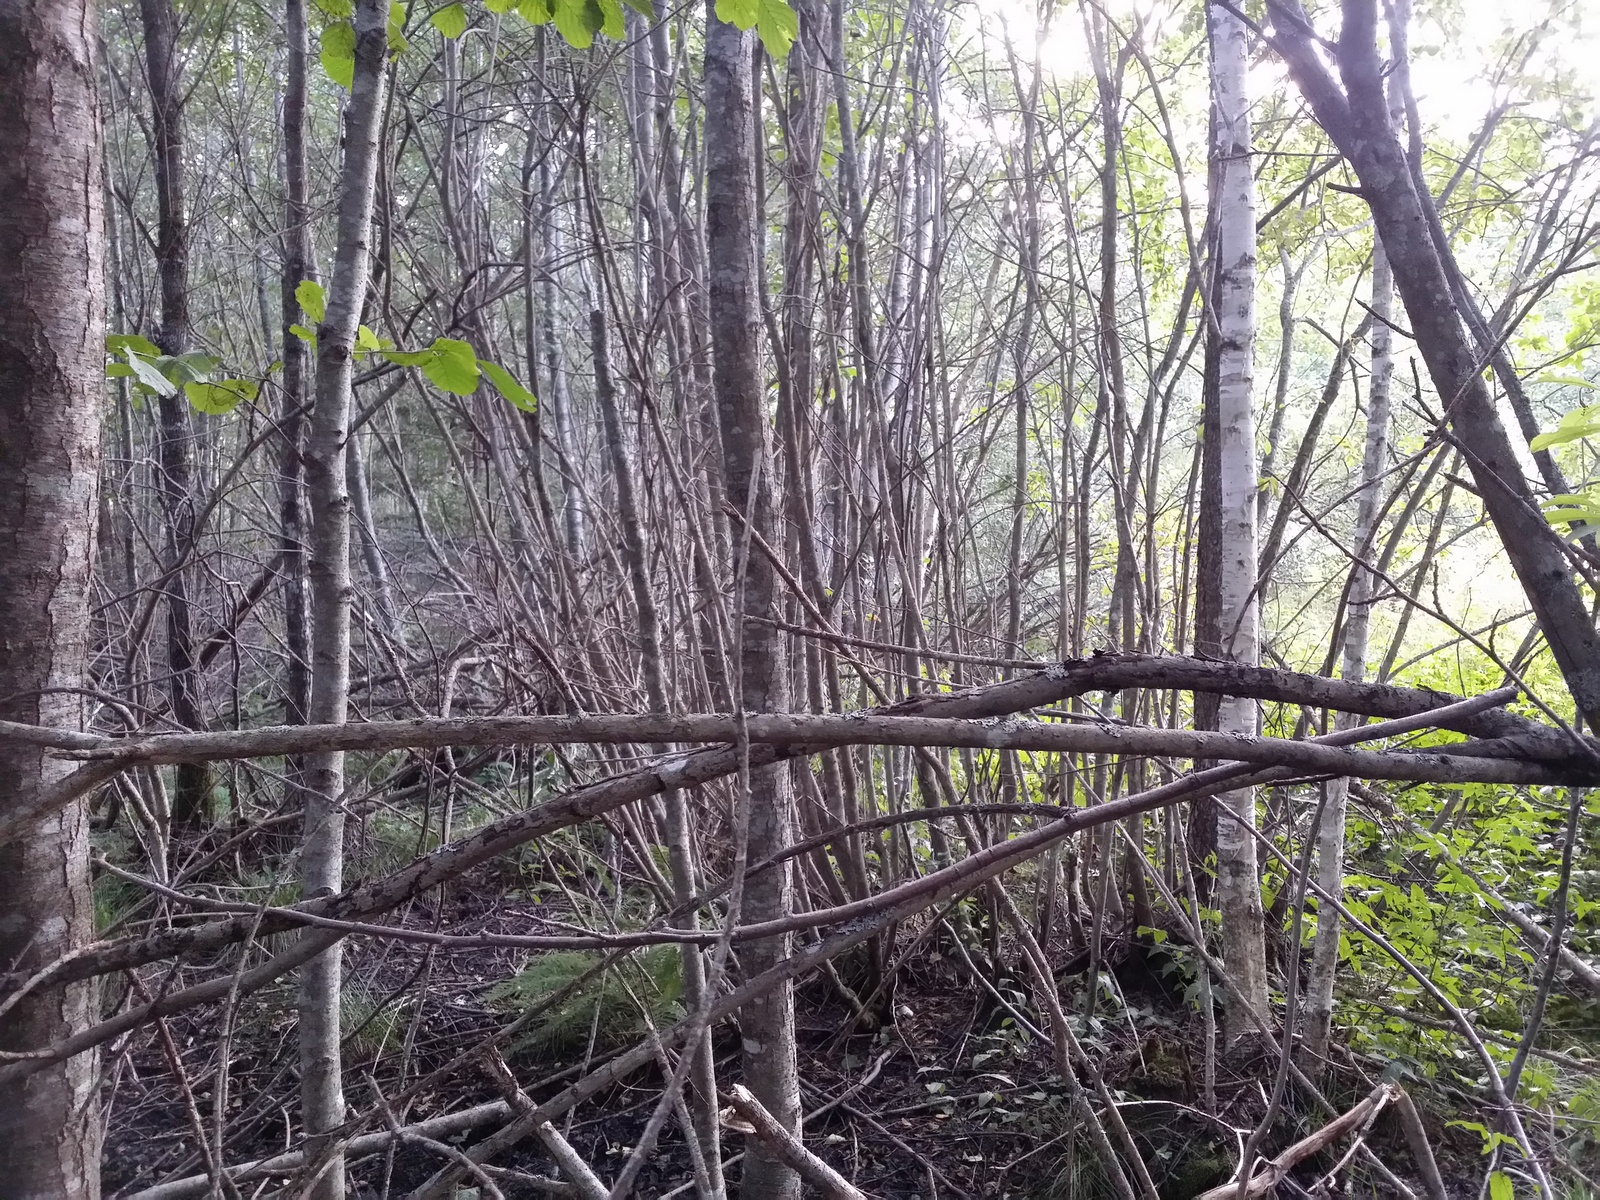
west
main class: Woodland
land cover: Broadleaved woodland
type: non-riverine alder, birch or aspen forest
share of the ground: > 75 %
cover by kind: broadleaved forest trees 85 %, herbaceous plants 10 %, unconsolidated bare surface 5 %
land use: Forestry
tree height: > 5 m
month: August
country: LV
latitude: 57.2337
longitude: 27.6930
